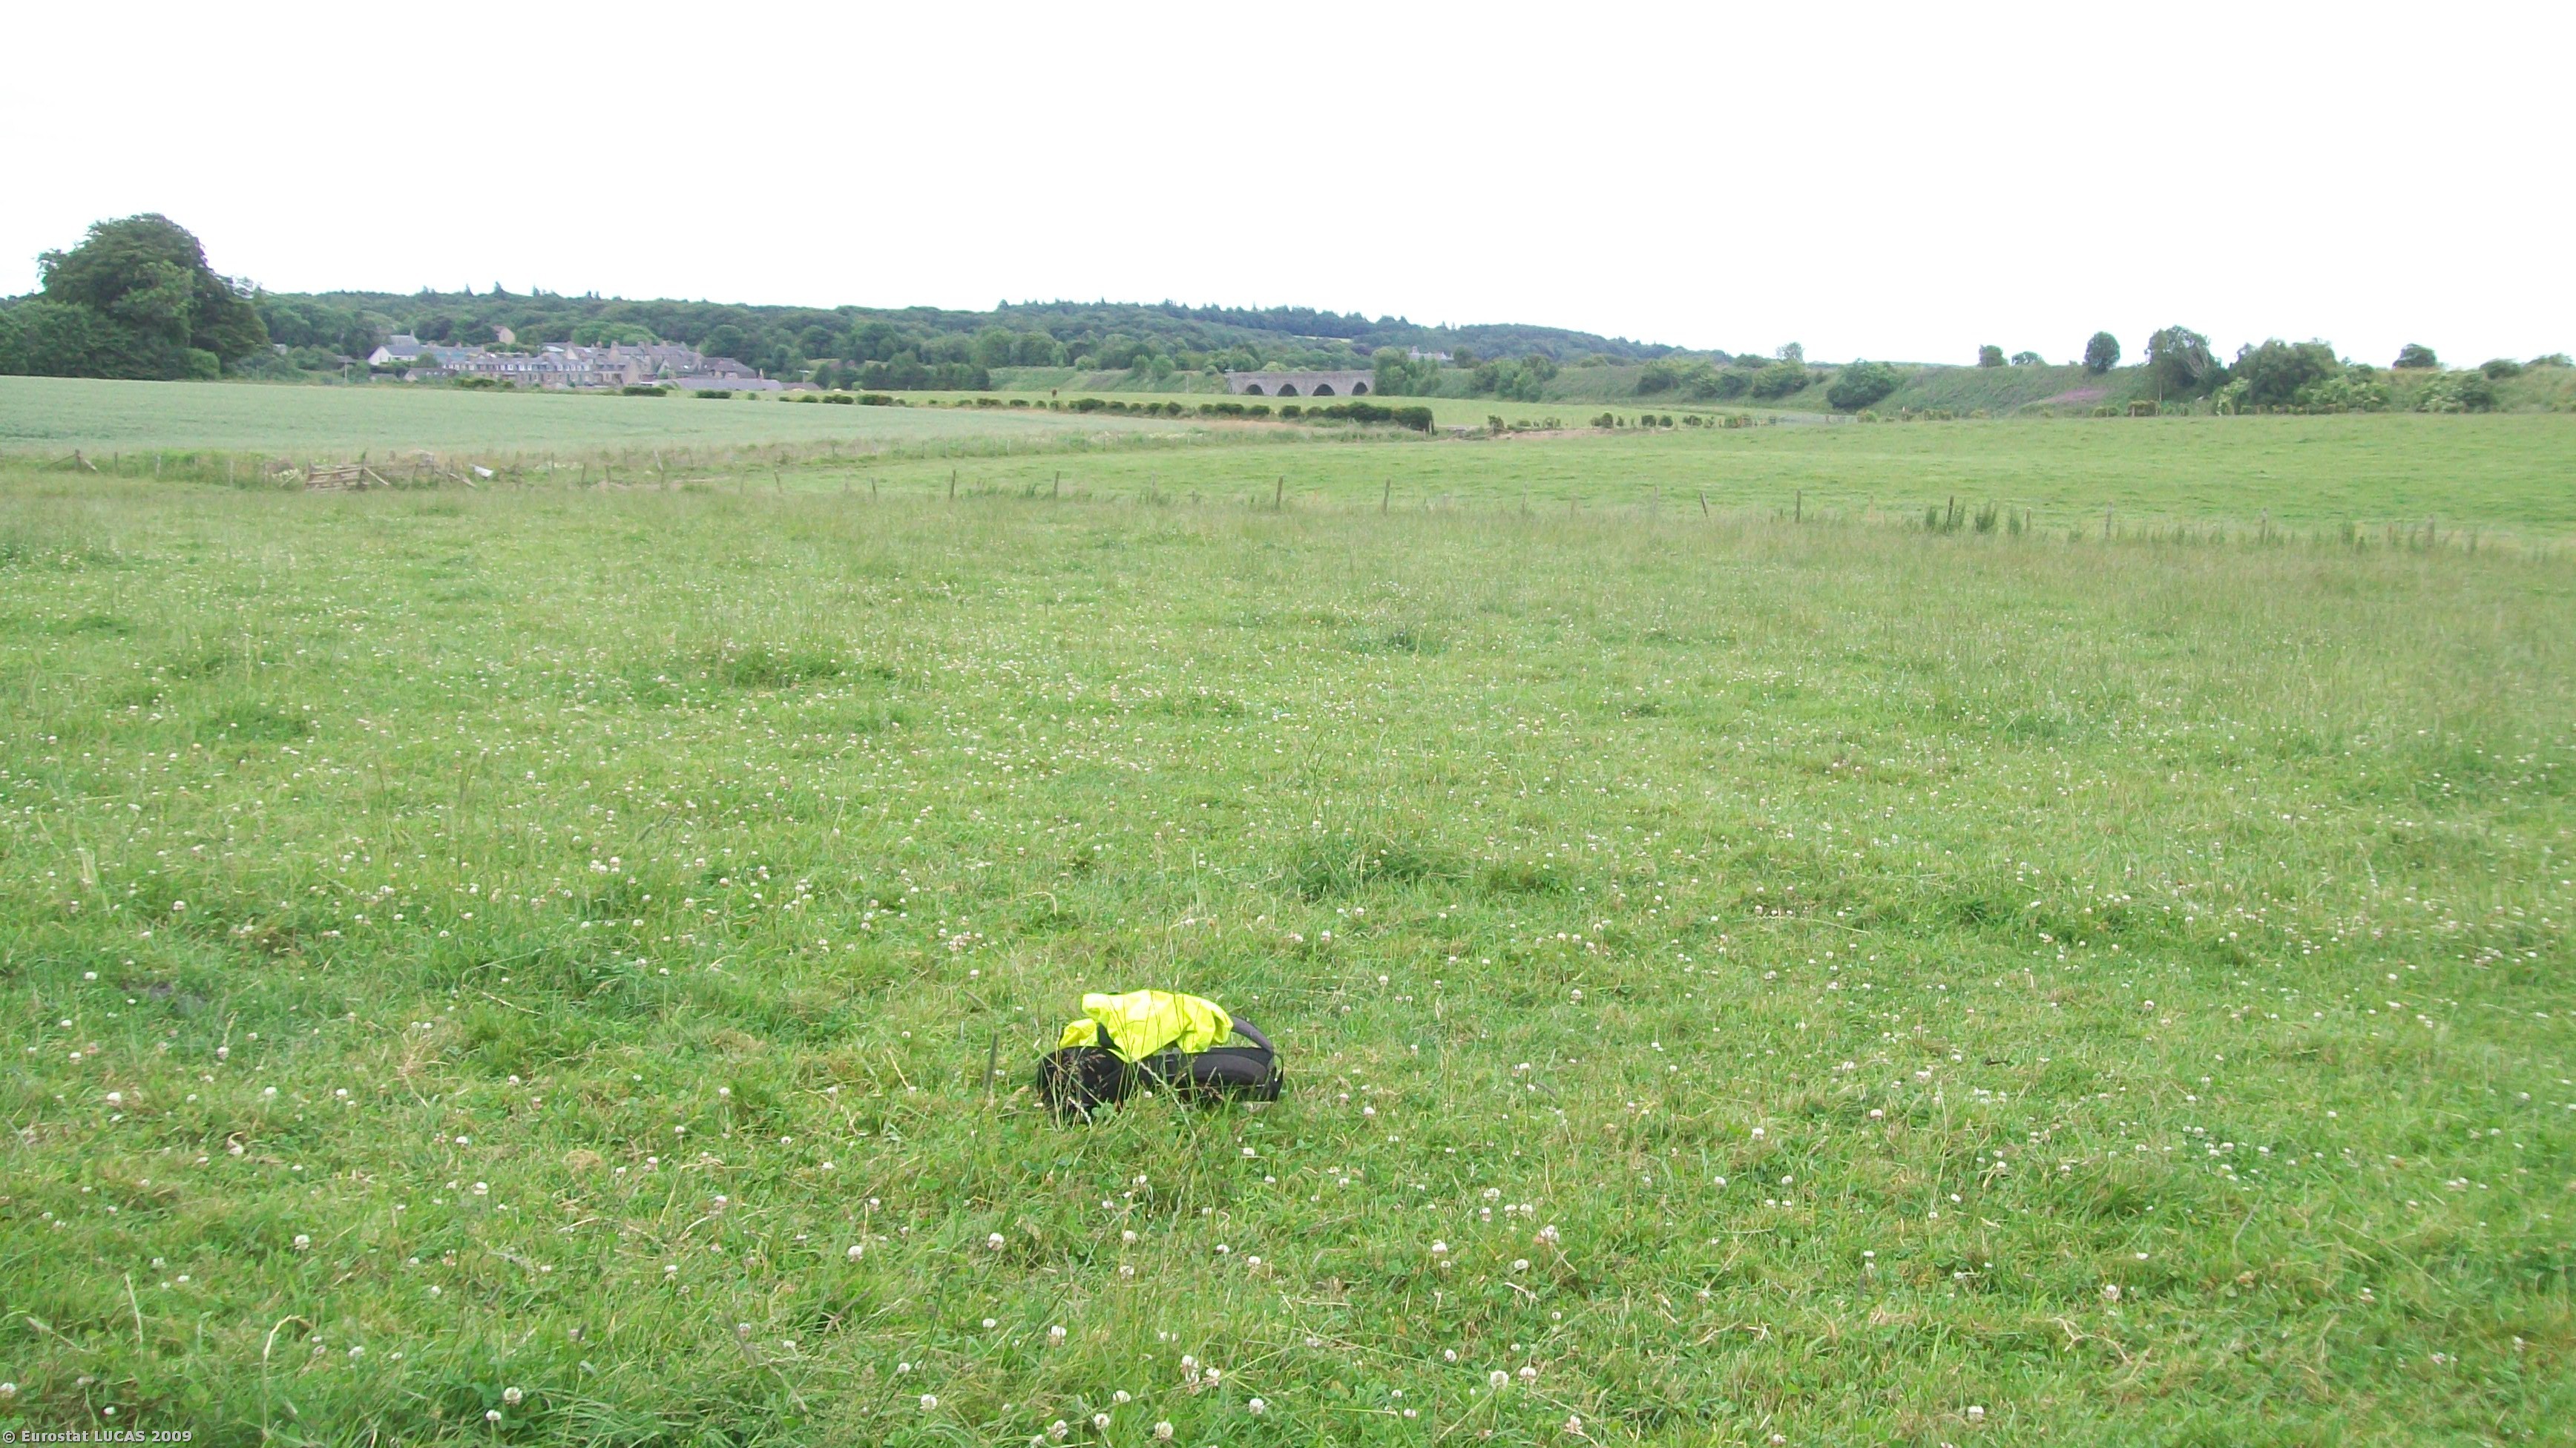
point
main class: Grassland
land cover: Grassland without tree/shrub cover
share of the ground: > 75 %
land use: Agriculture (excluding fallow land and kitchen gardens)
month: July
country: GB
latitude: 57.3607
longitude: -2.0995
